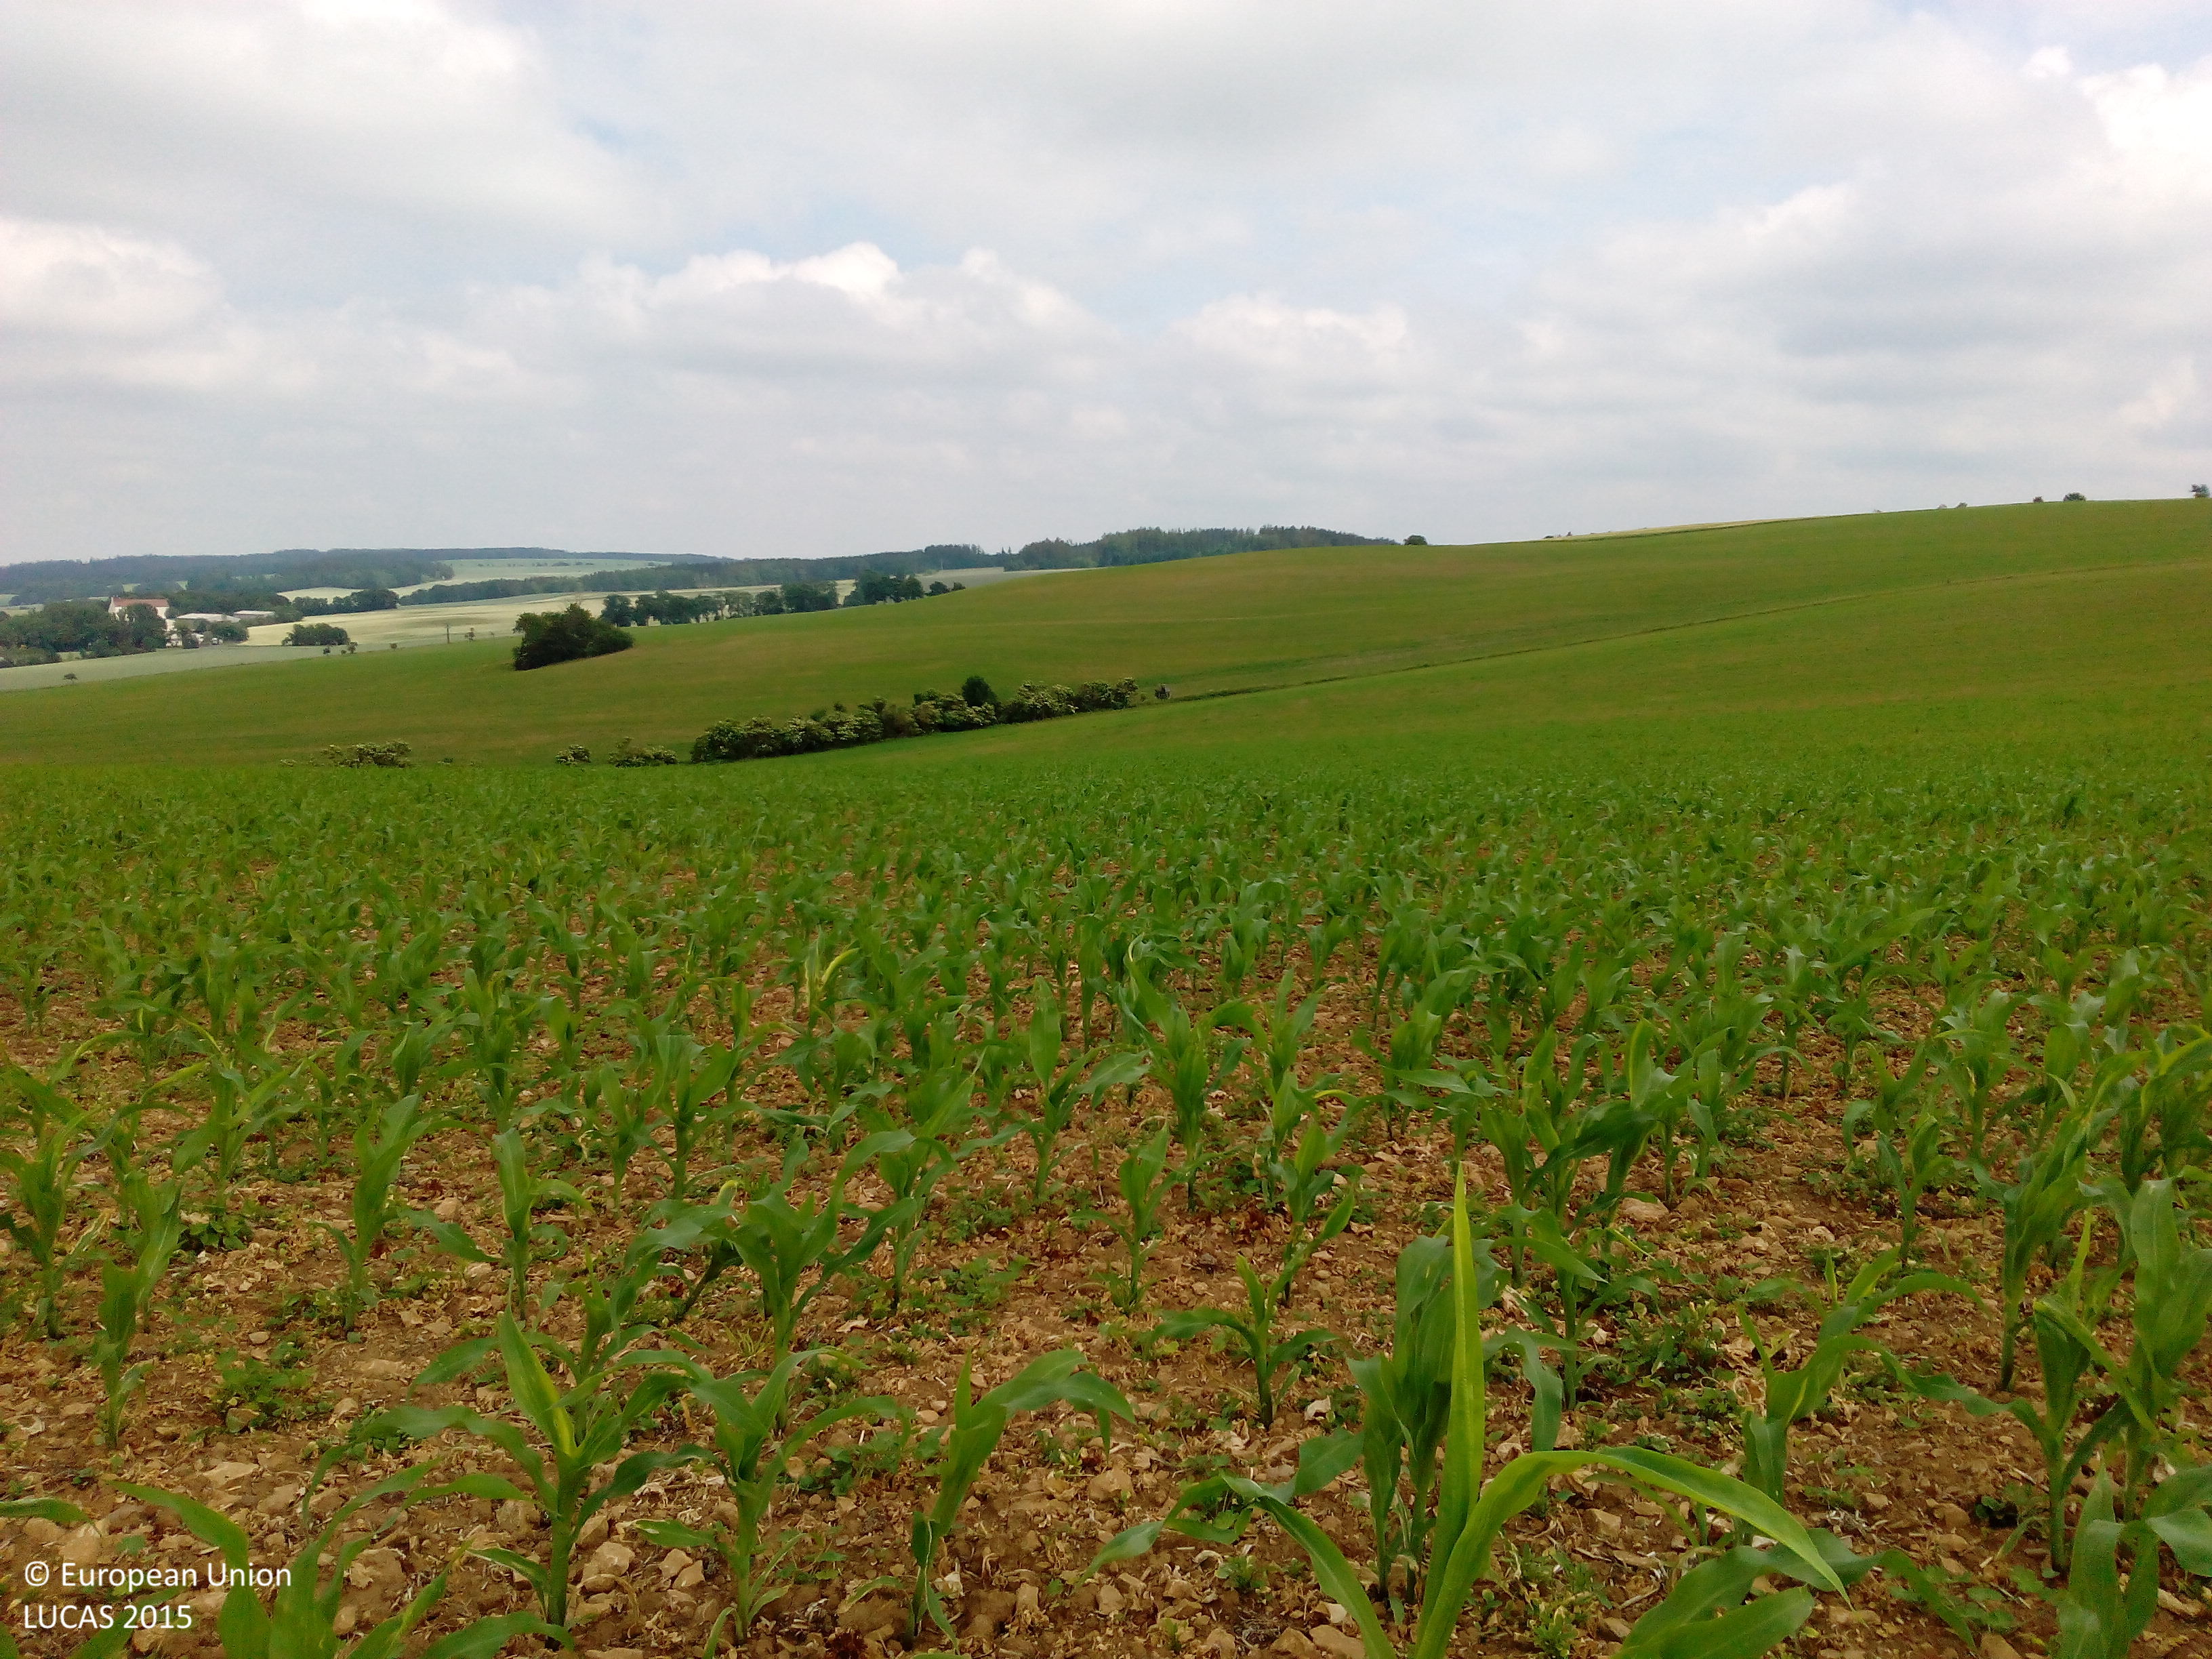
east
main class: Cropland
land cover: Maize
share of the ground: 25 - 50 %
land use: Agriculture (excluding fallow land and kitchen gardens)
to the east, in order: Maize; Broadleaved woodland; Tracks; Grass margins; Maize
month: June
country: DE
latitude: 50.6414
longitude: 11.5410
